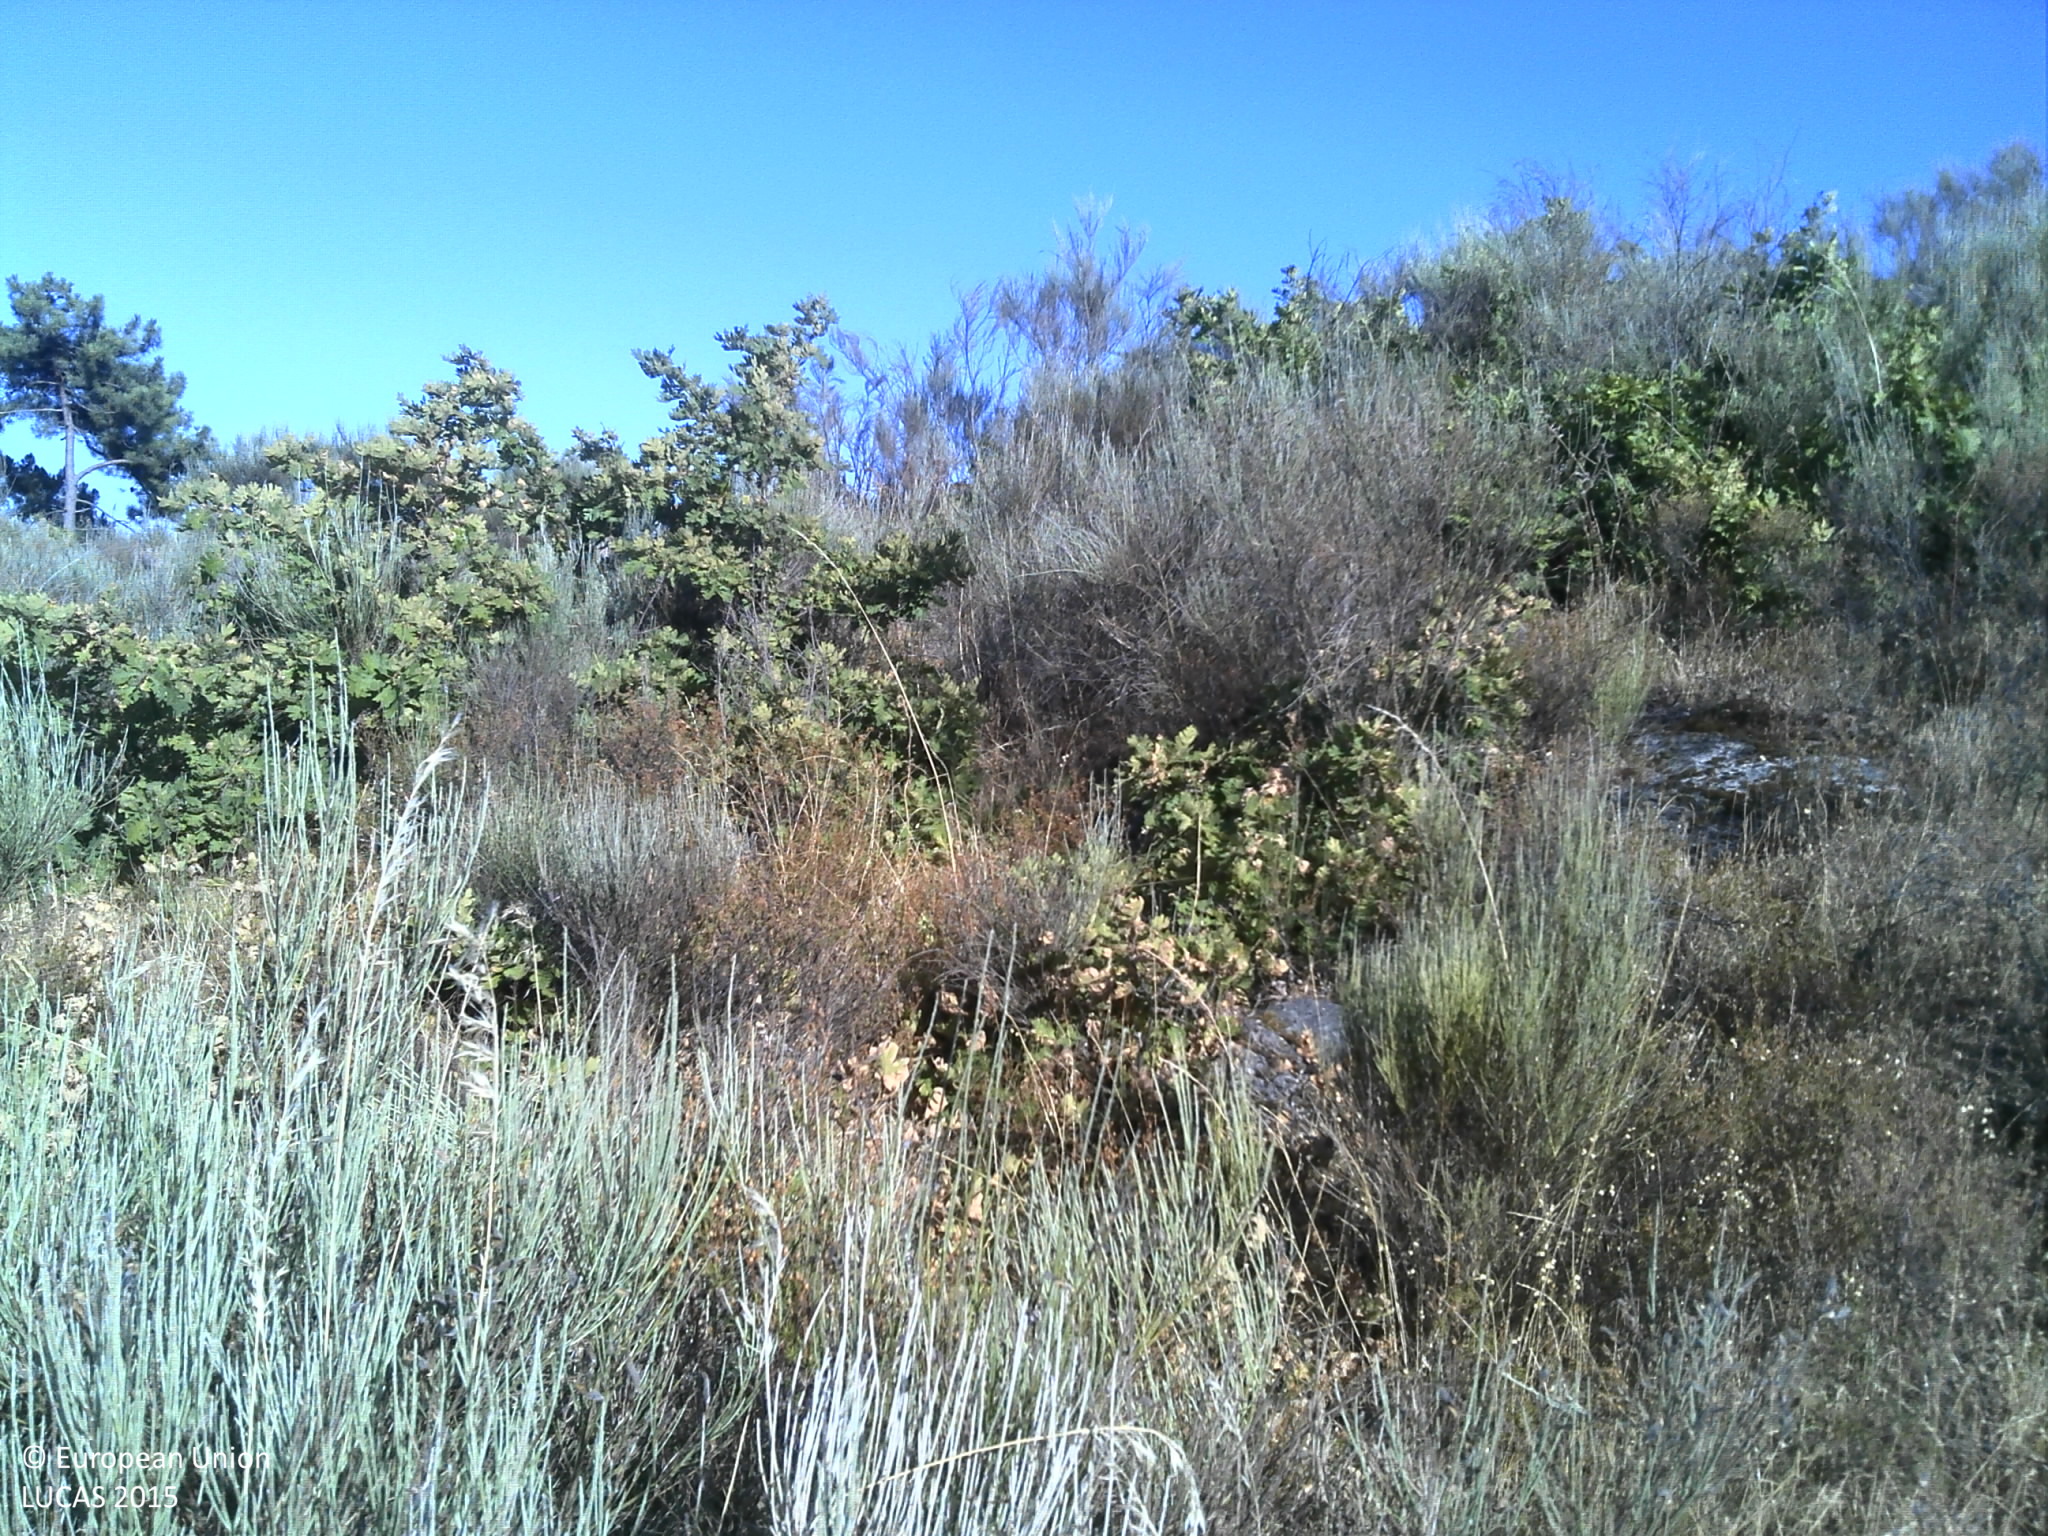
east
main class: Shrubland
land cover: Shrubland with sparse tree cover
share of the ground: > 75 %
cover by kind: shrubs 95 %, broadleaved forest trees 5 %
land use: Semi-natural and natural areas not in use
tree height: < 5 m
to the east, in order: Shrubland with sparse tree cover; Pine dominated coniferous woodland; Shrubland with sparse tree cover; Pine dominated coniferous woodland; Shrubland with sparse tree cover
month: July
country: PT
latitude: 41.2068
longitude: -7.3027
